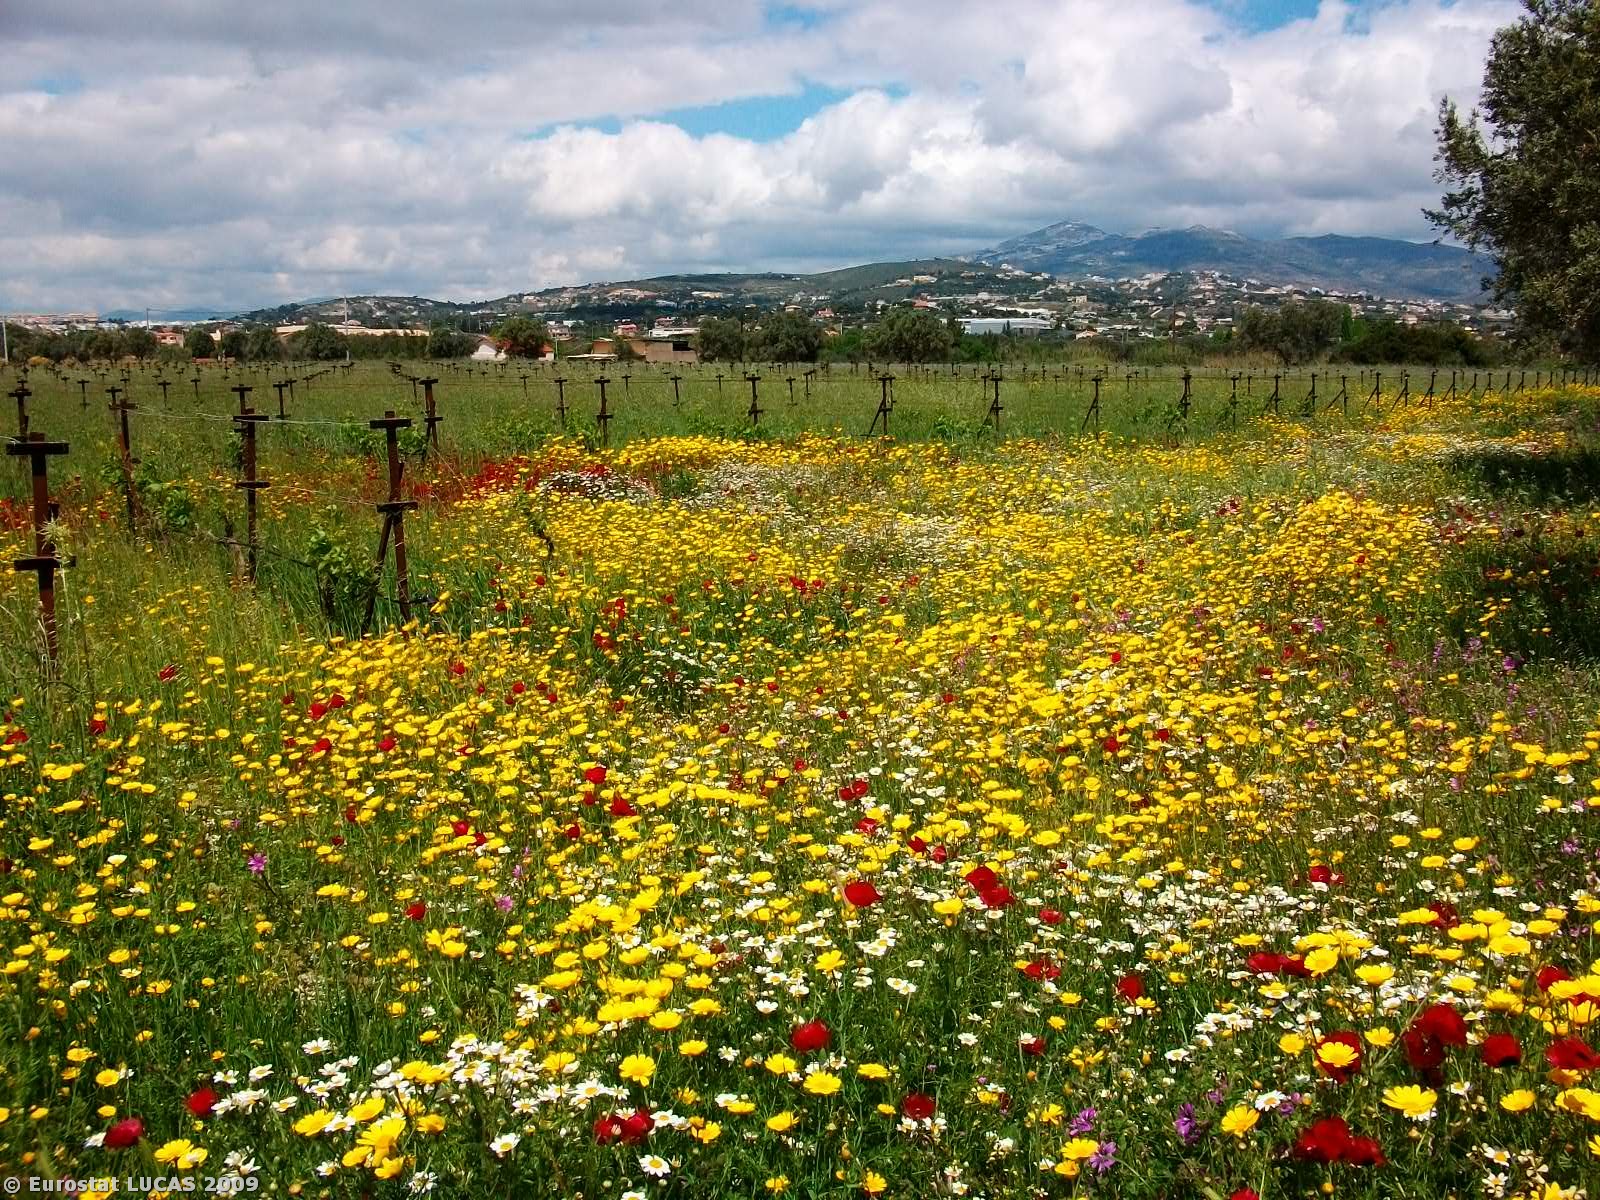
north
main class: Grassland
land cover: Grassland without tree/shrub cover
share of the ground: > 75 %
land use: Unused
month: May
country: GR
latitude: 37.9874
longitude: 23.9076
